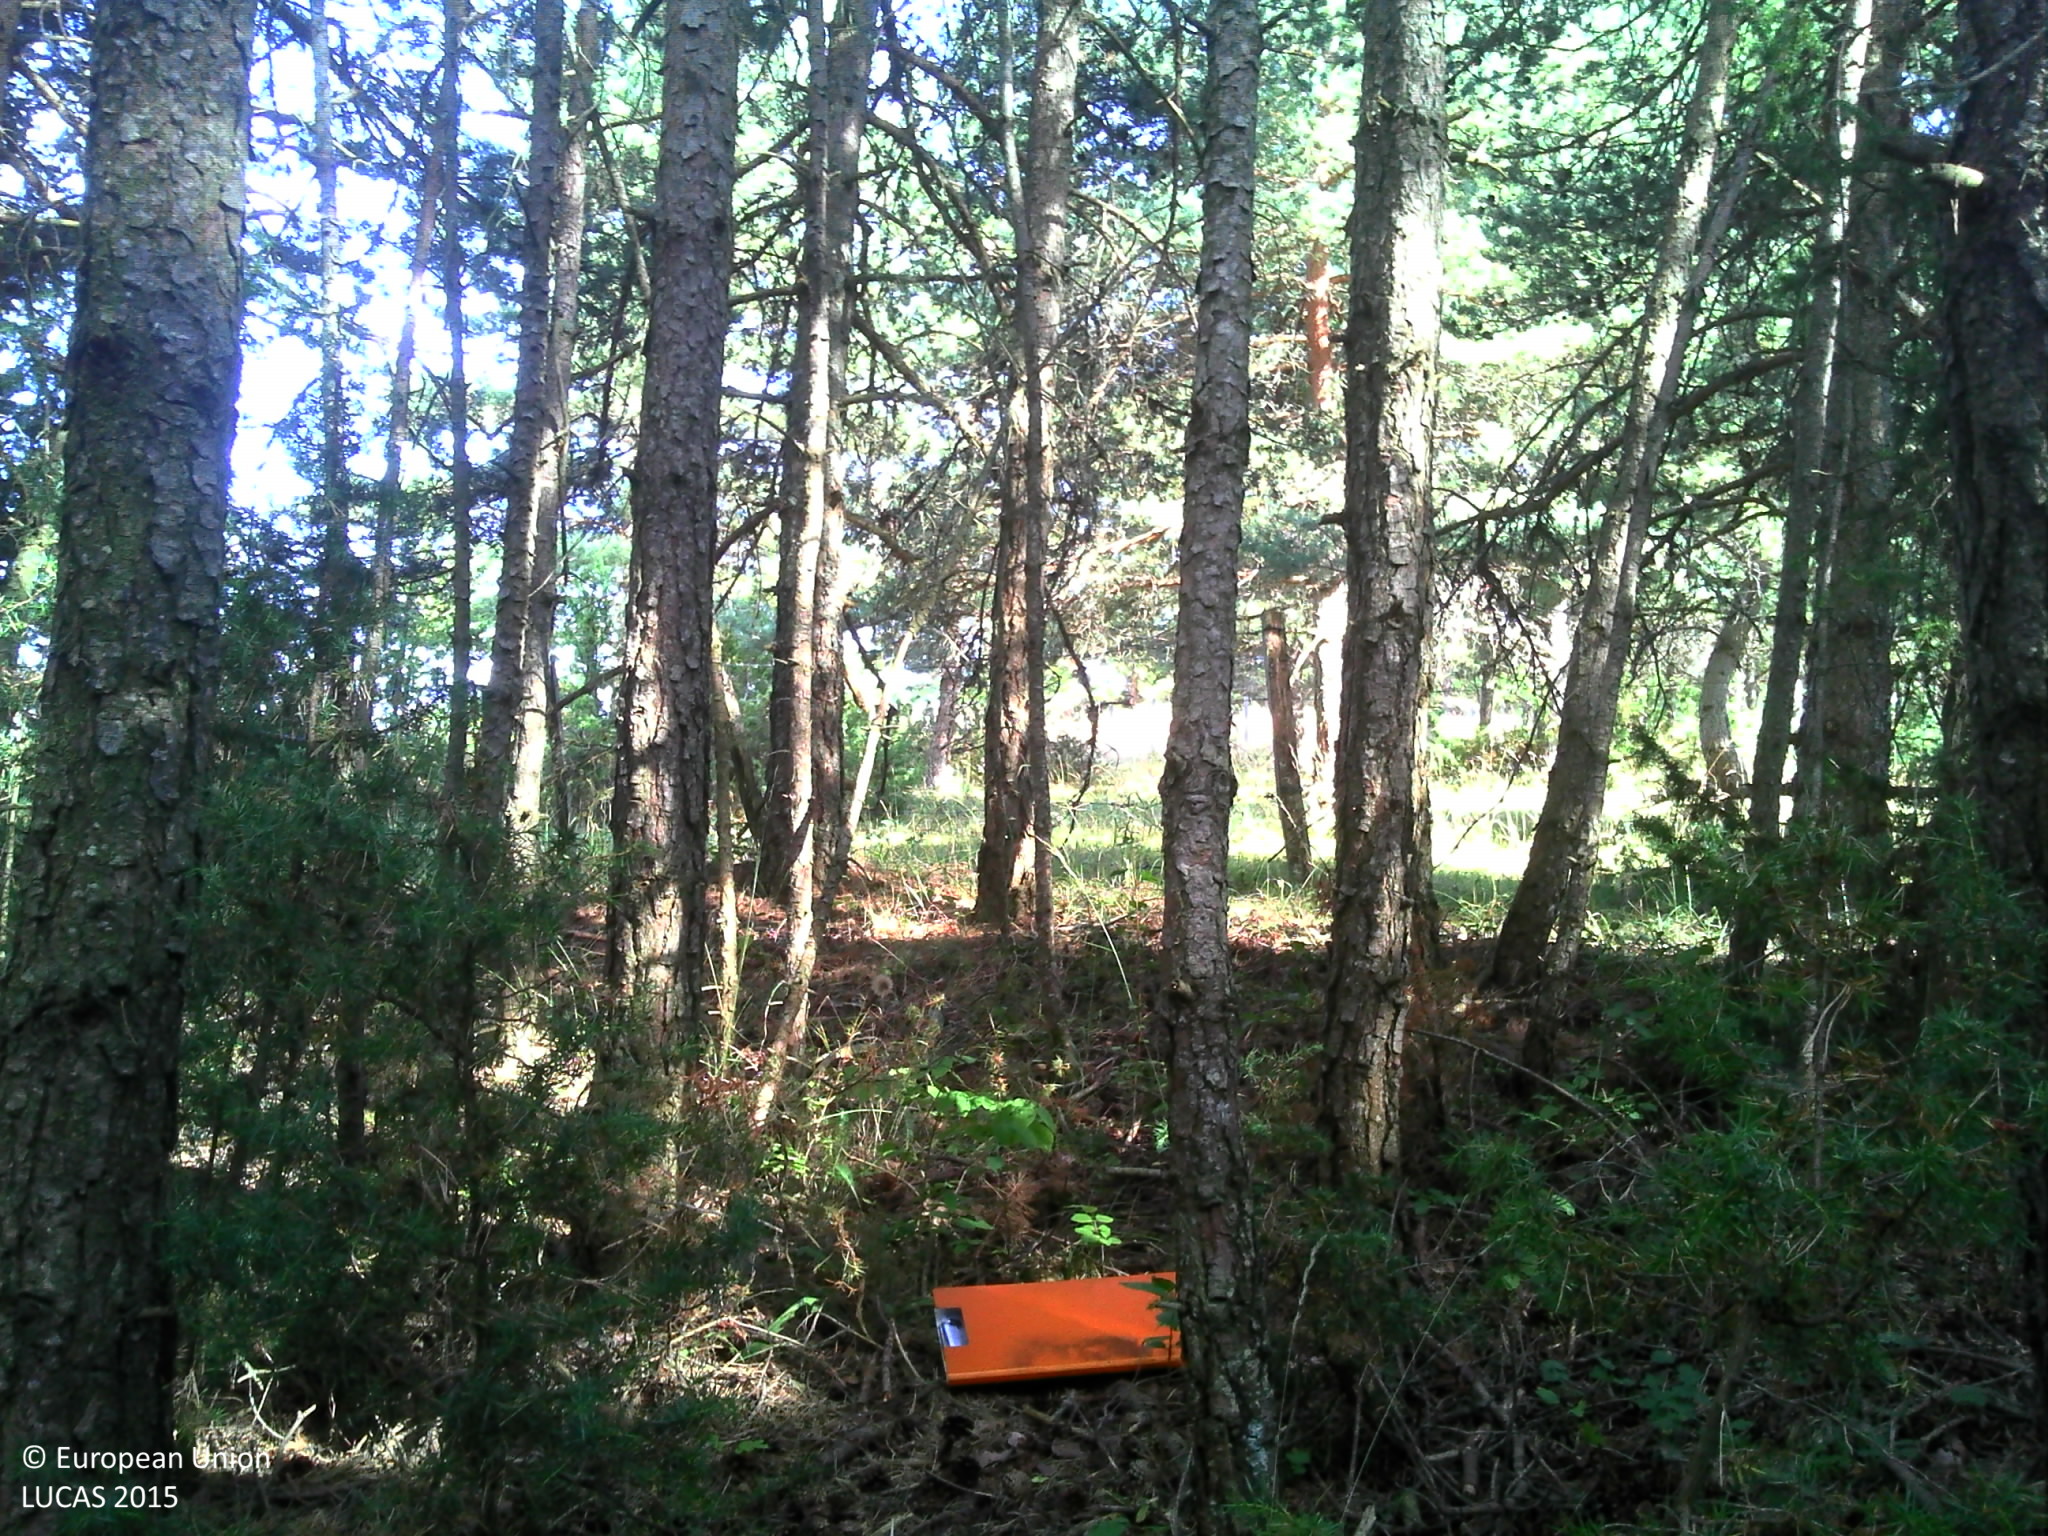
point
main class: Woodland
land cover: Pine dominated coniferous woodland
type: hemiboreal forest and nemoral coniferous forest and mixed broadleaved-coniferous forest
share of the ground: > 75 %
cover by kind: coniferous forest trees 95 %, broadleaved forest trees 5 %
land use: Forestry
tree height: > 5 m
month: July
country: FR
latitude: 44.5253
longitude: 3.1974
